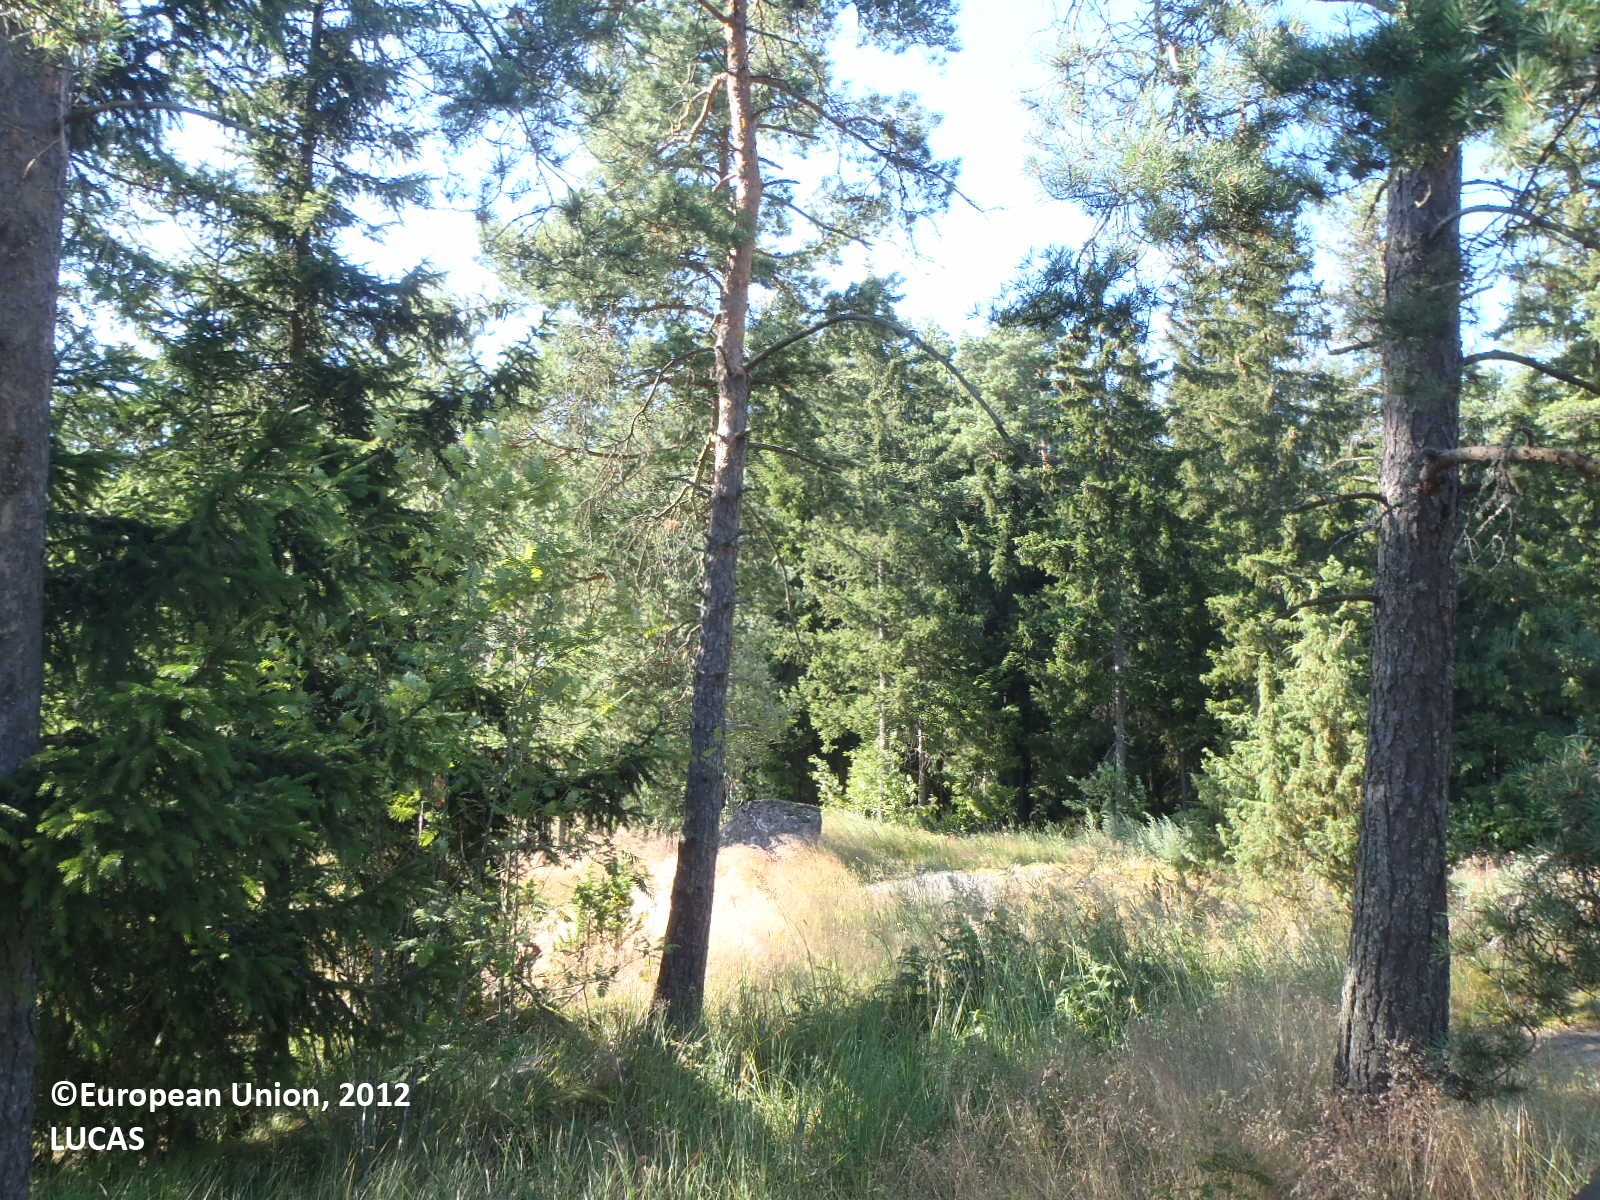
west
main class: Woodland
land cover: Pine dominated coniferous woodland
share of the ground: 25 - 50 %
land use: Forestry
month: July
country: FI
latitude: 60.6572
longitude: 21.7117
